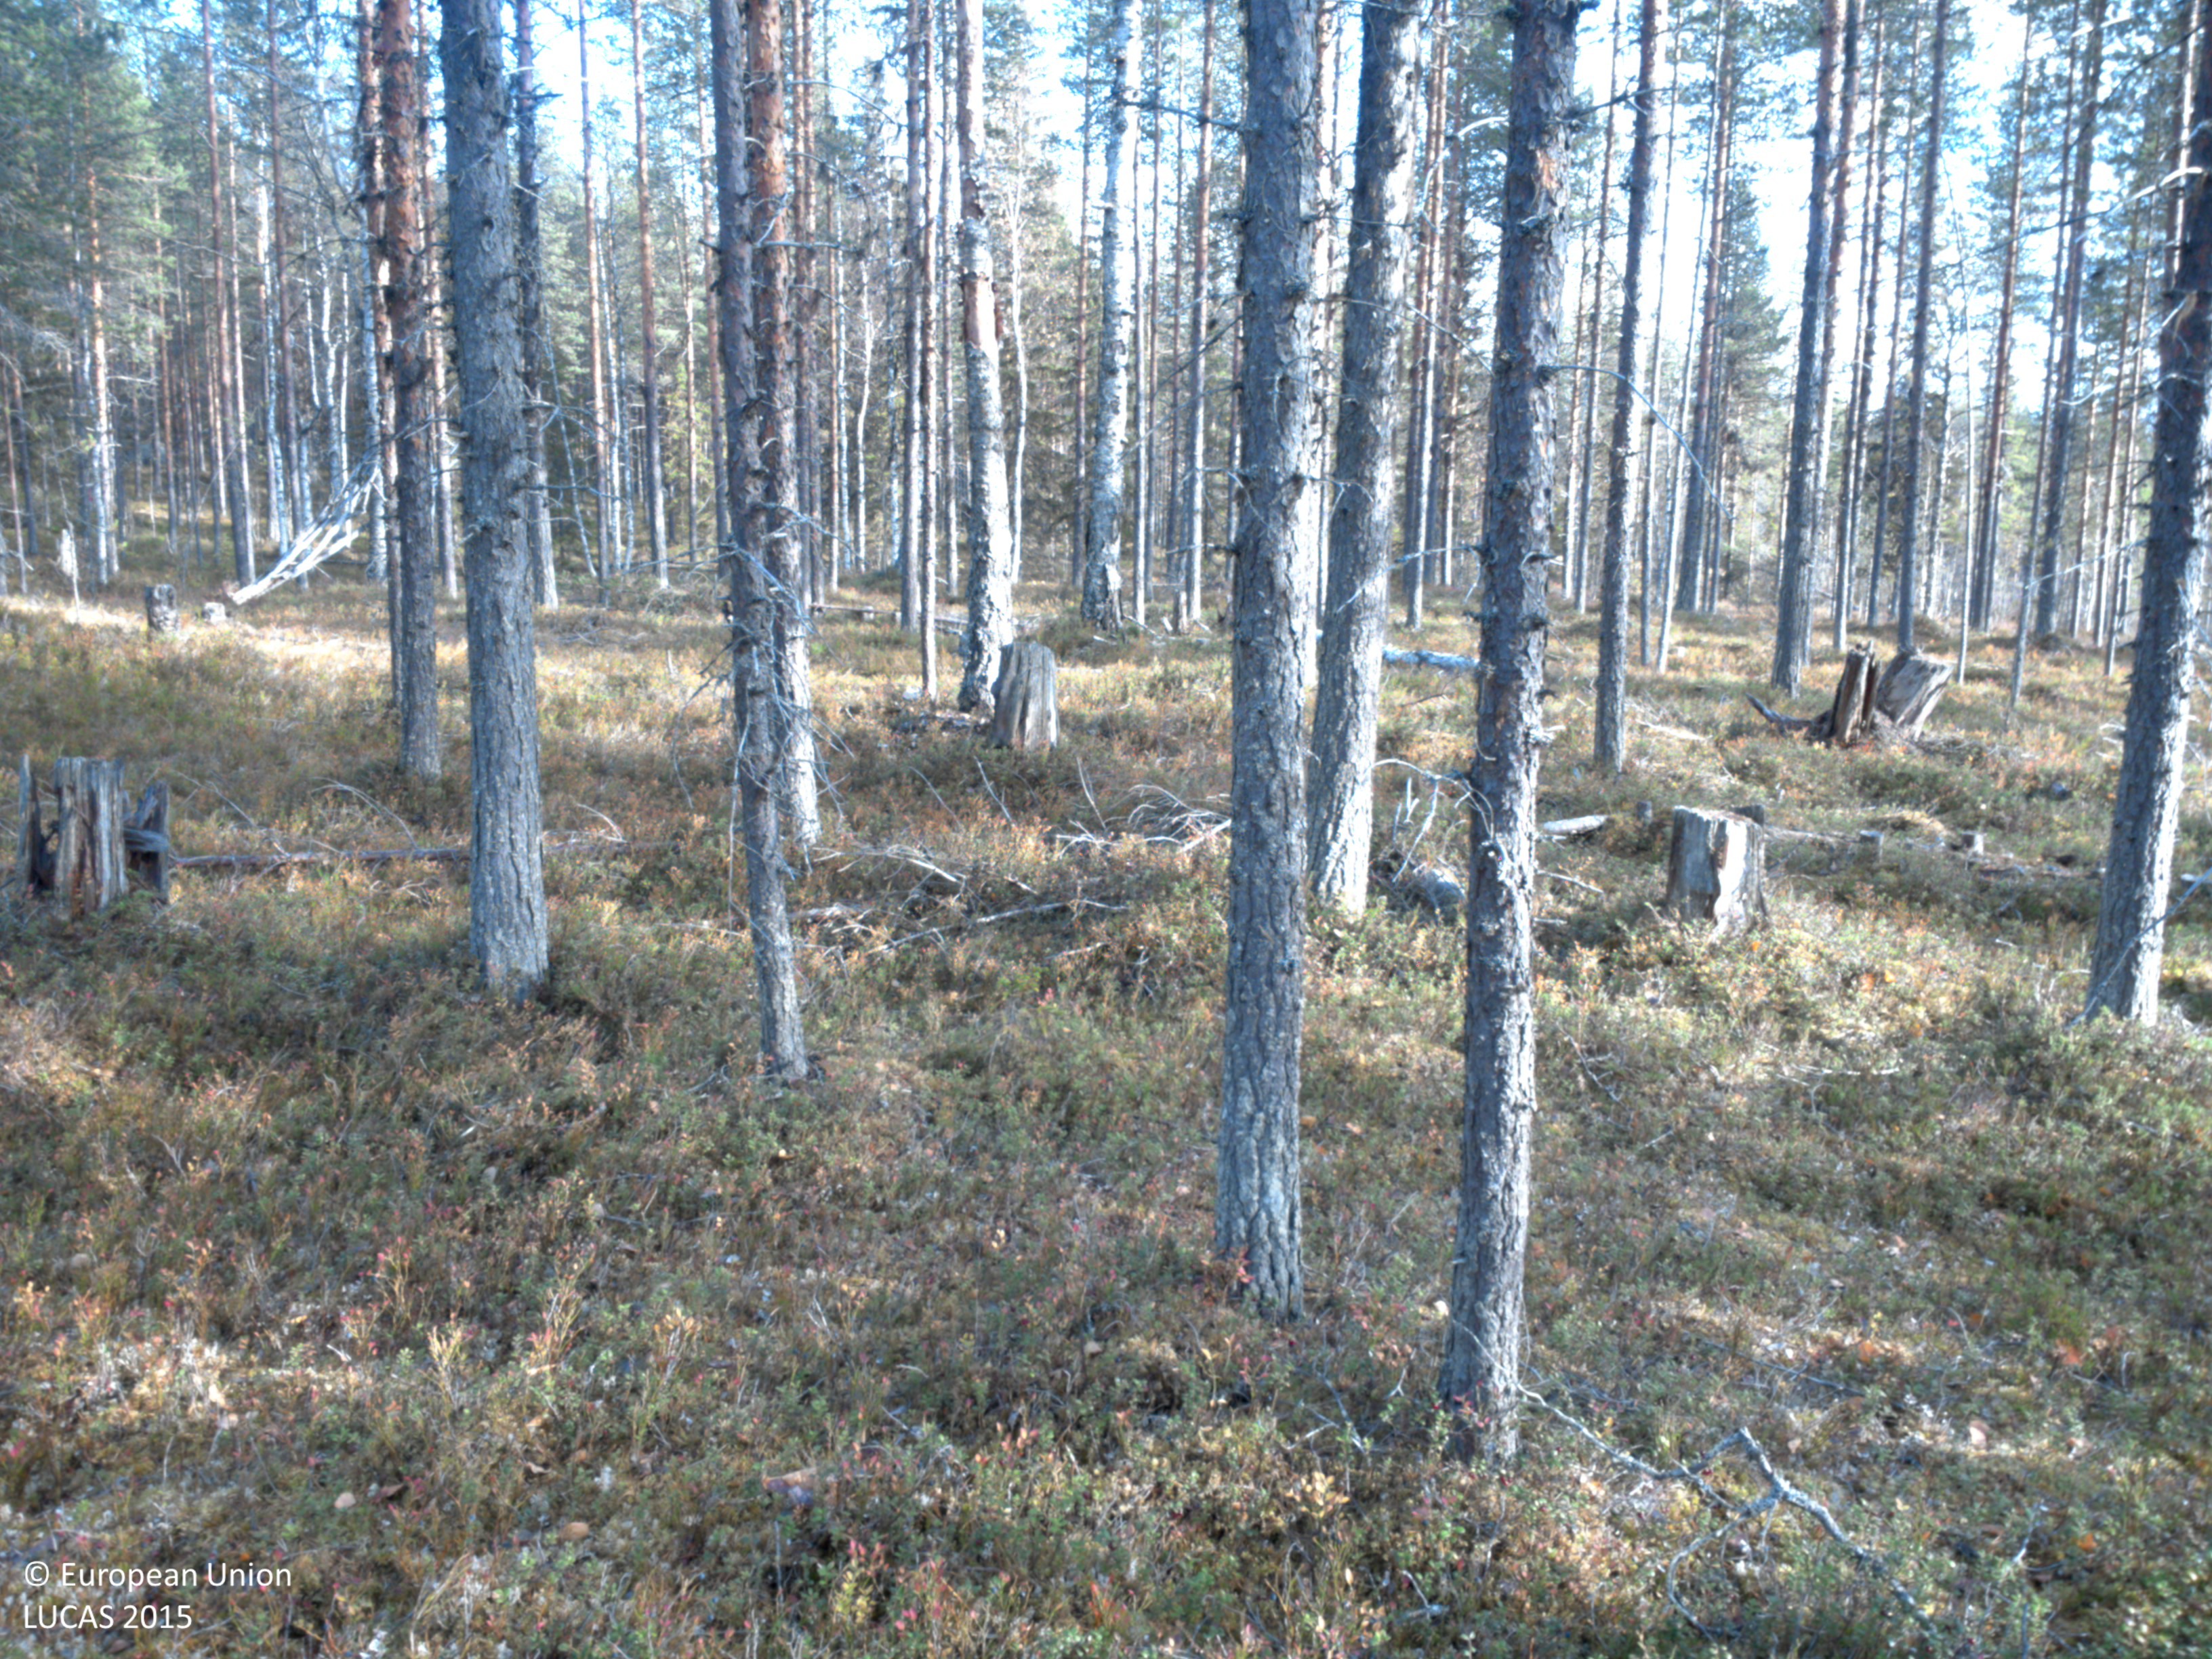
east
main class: Woodland
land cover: Pine dominated coniferous woodland
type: boreal forest
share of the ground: 50 - 75 %
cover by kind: coniferous forest trees 55 %, shrubs 30 %, lichens and mosses 10 %, herbaceous plants 5 %
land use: Forestry
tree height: > 5 m
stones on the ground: < 10 %
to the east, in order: Pine dominated coniferous woodland; Pine dominated mixed woodland; Pine dominated coniferous woodland; Pine dominated mixed woodland; Pine dominated coniferous woodland; Pine dominated mixed woodland
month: October
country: SE
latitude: 64.8443
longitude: 19.1388
